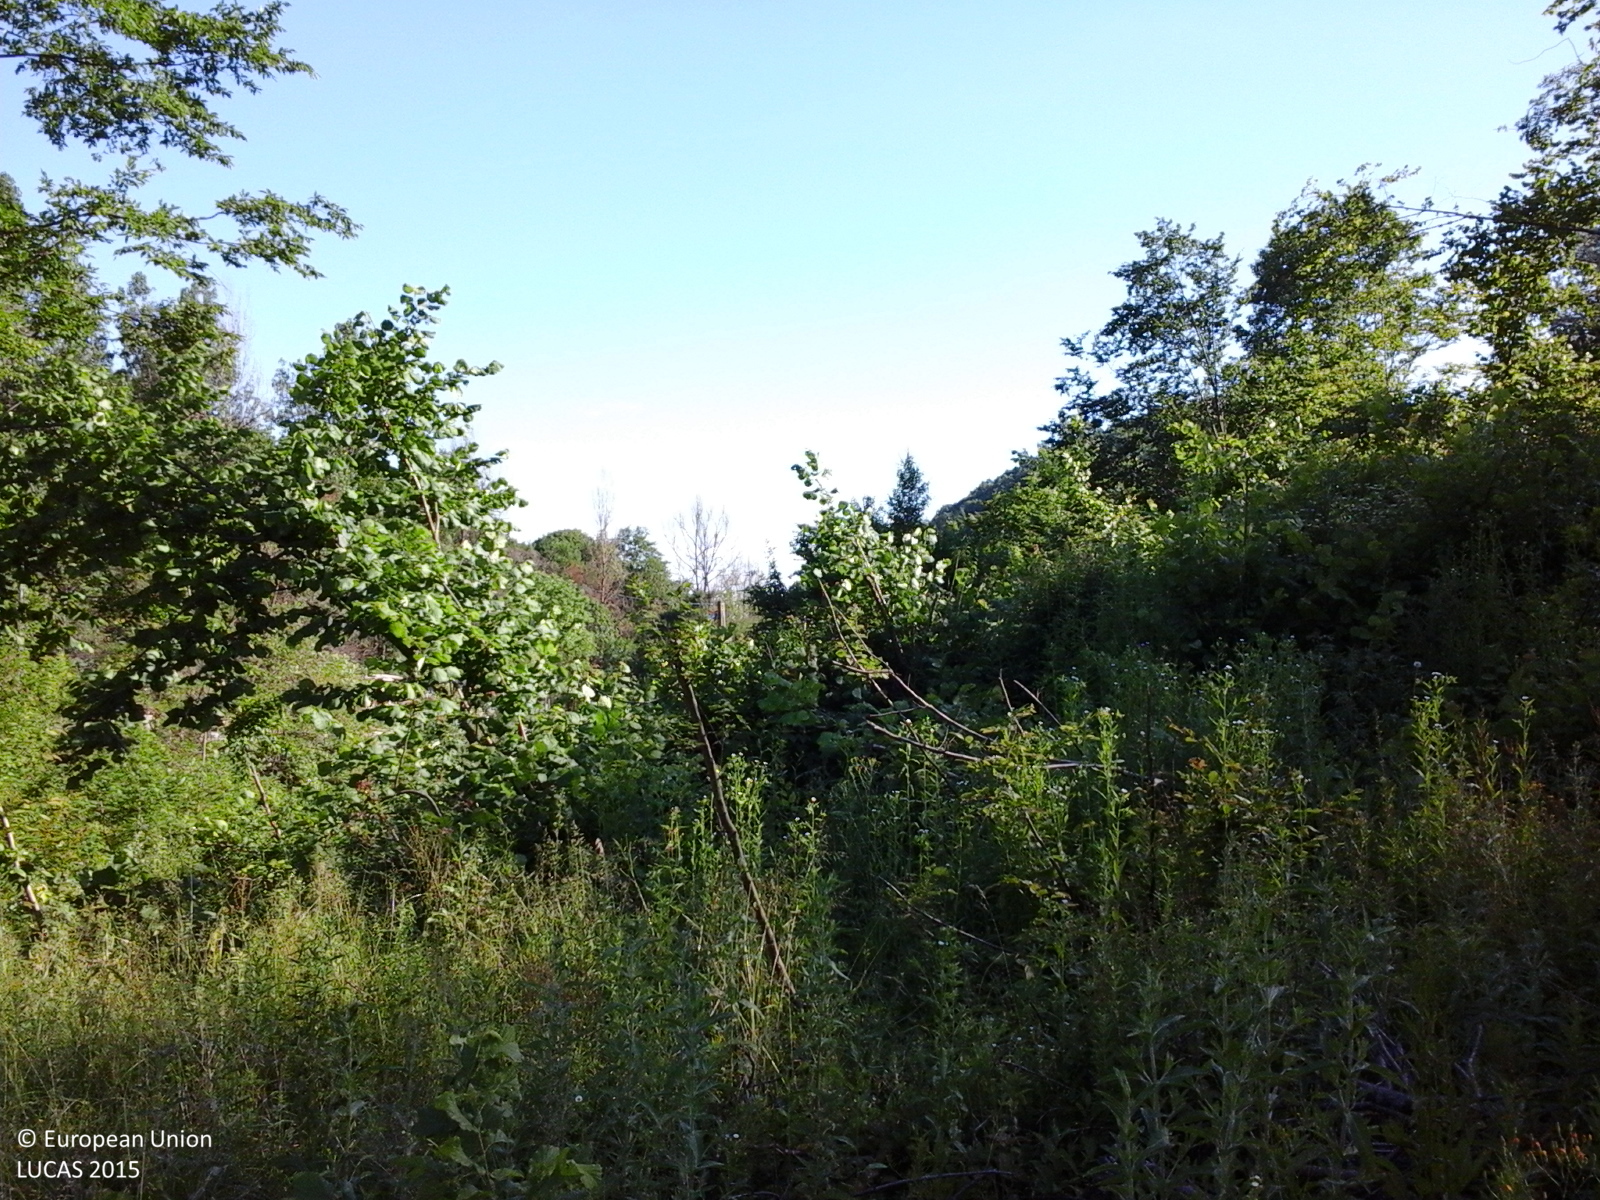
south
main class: Grassland
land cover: Spontaneously vegetated surfaces
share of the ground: > 75 %
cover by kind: herbaceous plants 100 %
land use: Forestry
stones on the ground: < 10 %
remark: Clear cut
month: June
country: RO
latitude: 45.1083
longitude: 25.8271
